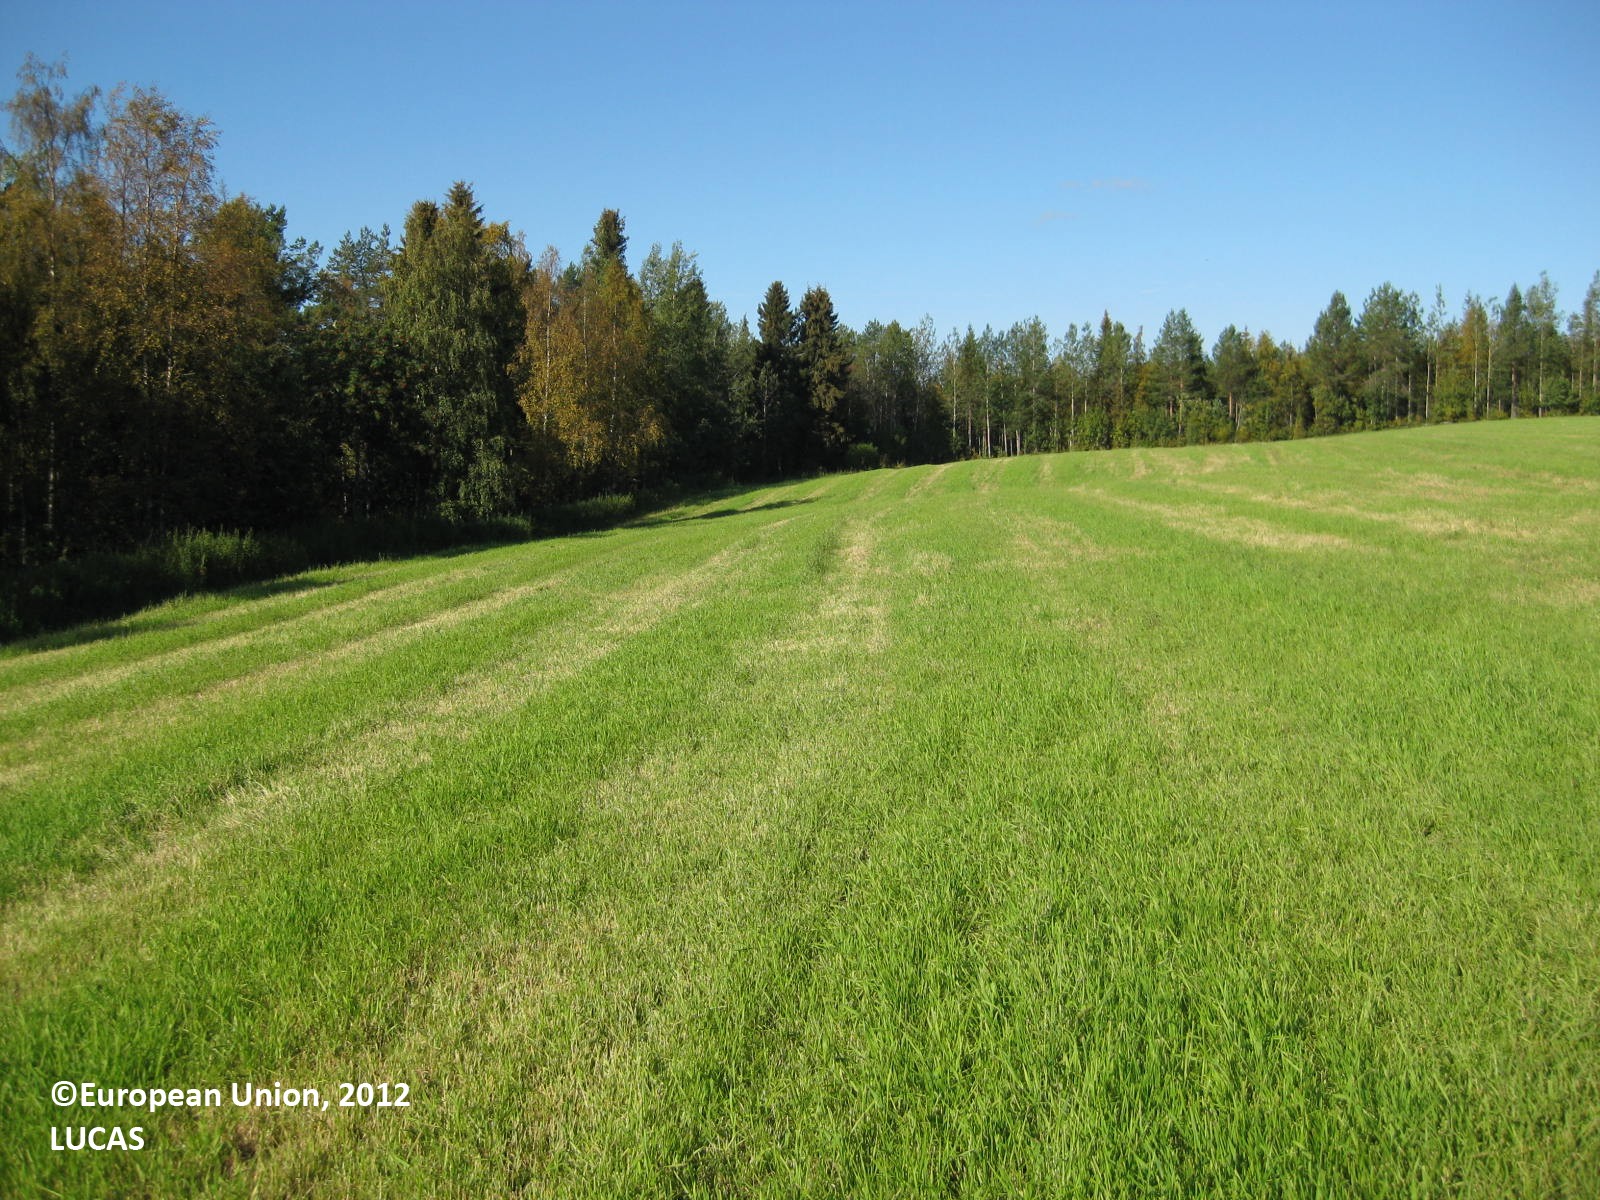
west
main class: Cropland
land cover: Temporary grasslands
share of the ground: > 75 %
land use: Agriculture (excluding fallow land and kitchen gardens)
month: August
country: FI
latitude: 66.0815
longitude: 29.6230
